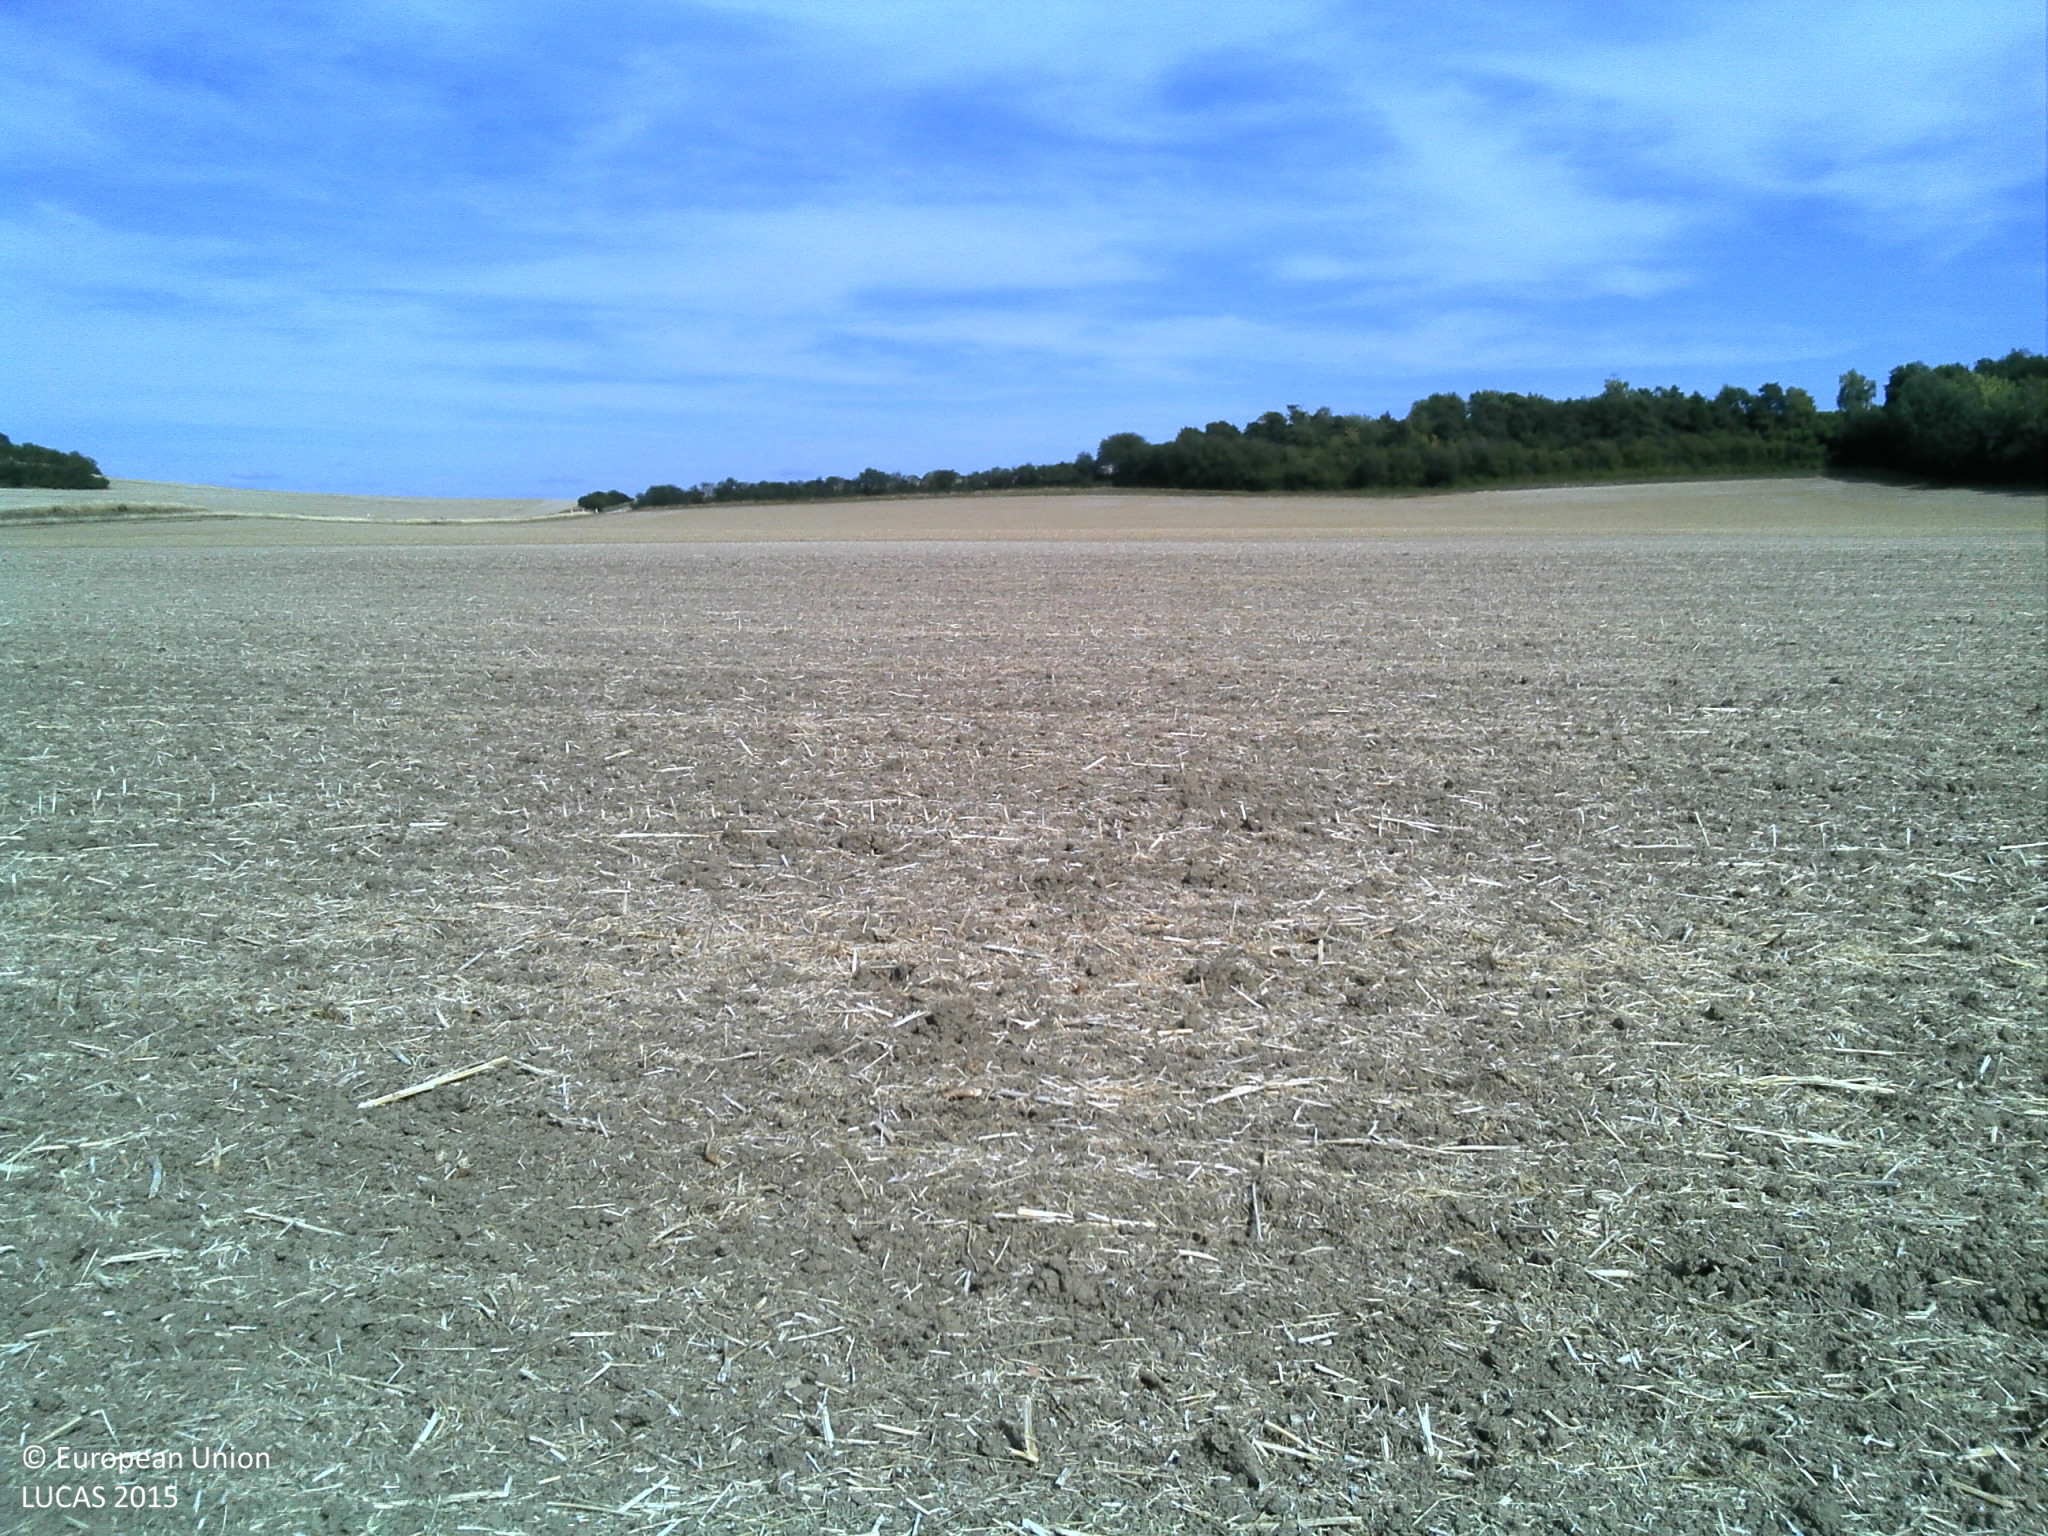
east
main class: Cropland
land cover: Rape and turnip rape
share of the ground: > 75 %
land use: Agriculture (excluding fallow land and kitchen gardens)
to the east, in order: Rape and turnip rape; Common wheat
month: August
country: FR
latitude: 49.0031
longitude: 4.8167
